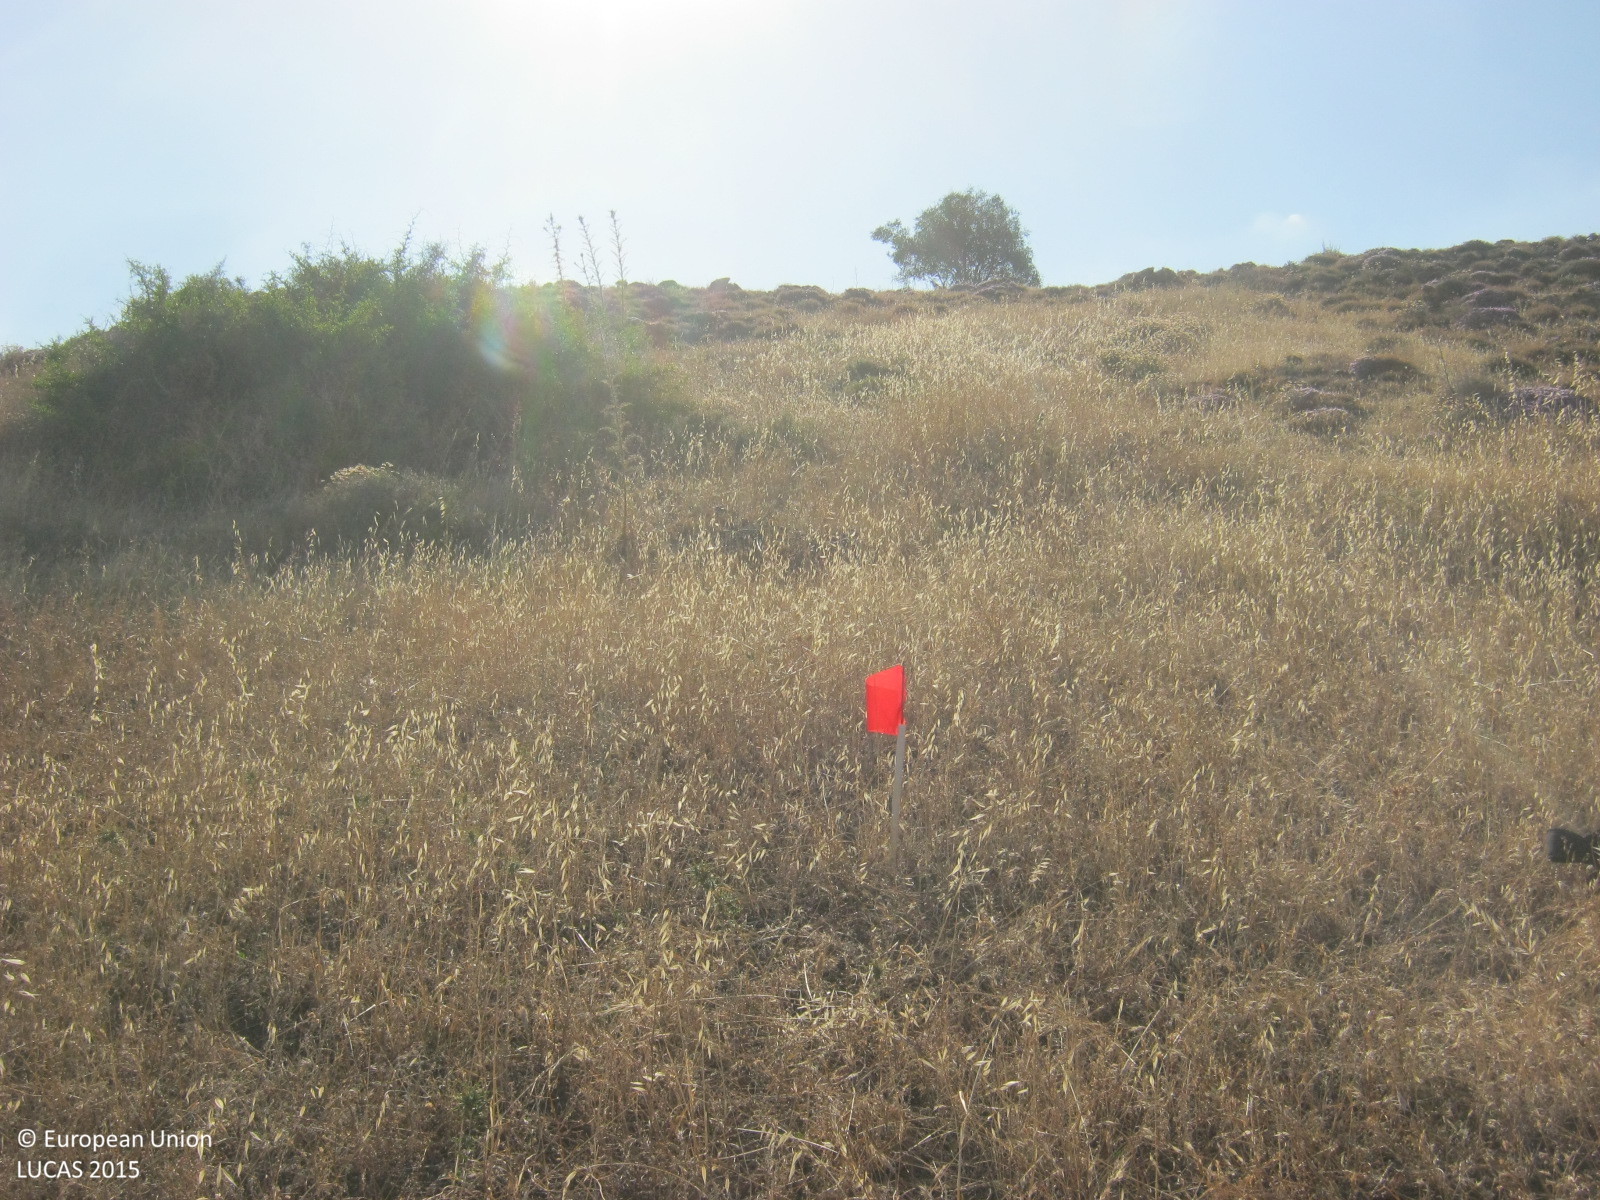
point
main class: Shrubland
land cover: Shrubland without tree cover
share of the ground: 10 - 25 %
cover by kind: herbaceous plants 70 %, shrubs 20 %, unconsolidated bare surface 10 %
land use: Semi-natural and natural areas not in use
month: June
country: CY
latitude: 35.0798
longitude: 32.9084
